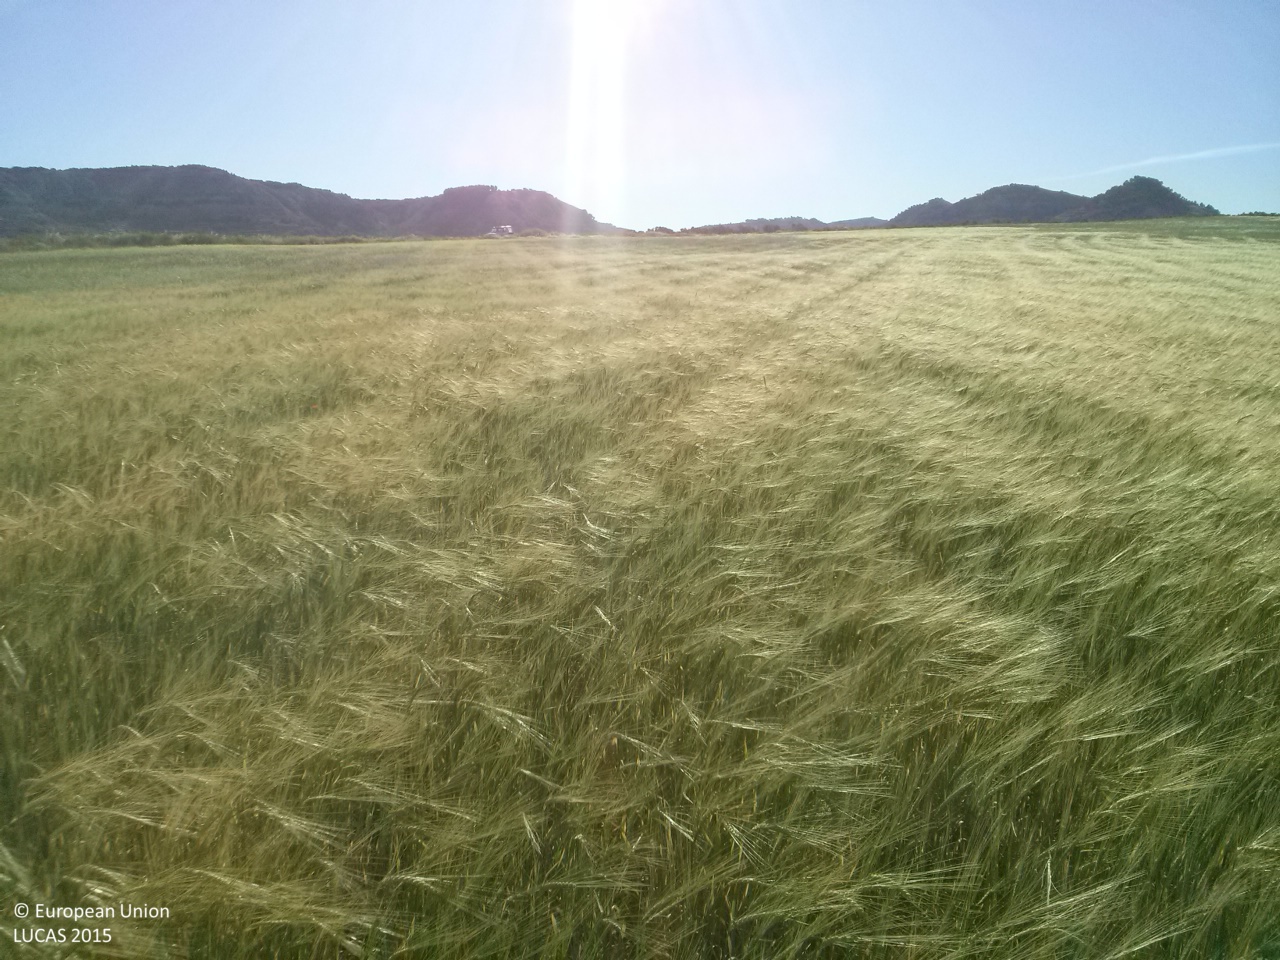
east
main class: Cropland
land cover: Barley
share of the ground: > 75 %
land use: Agriculture (excluding fallow land and kitchen gardens)
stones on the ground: < 10 %
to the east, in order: Barley; Grass margins; Tracks; Grass margins; Spontaneously vegetated surfaces
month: May
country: ES
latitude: 40.2988
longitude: -2.5519
